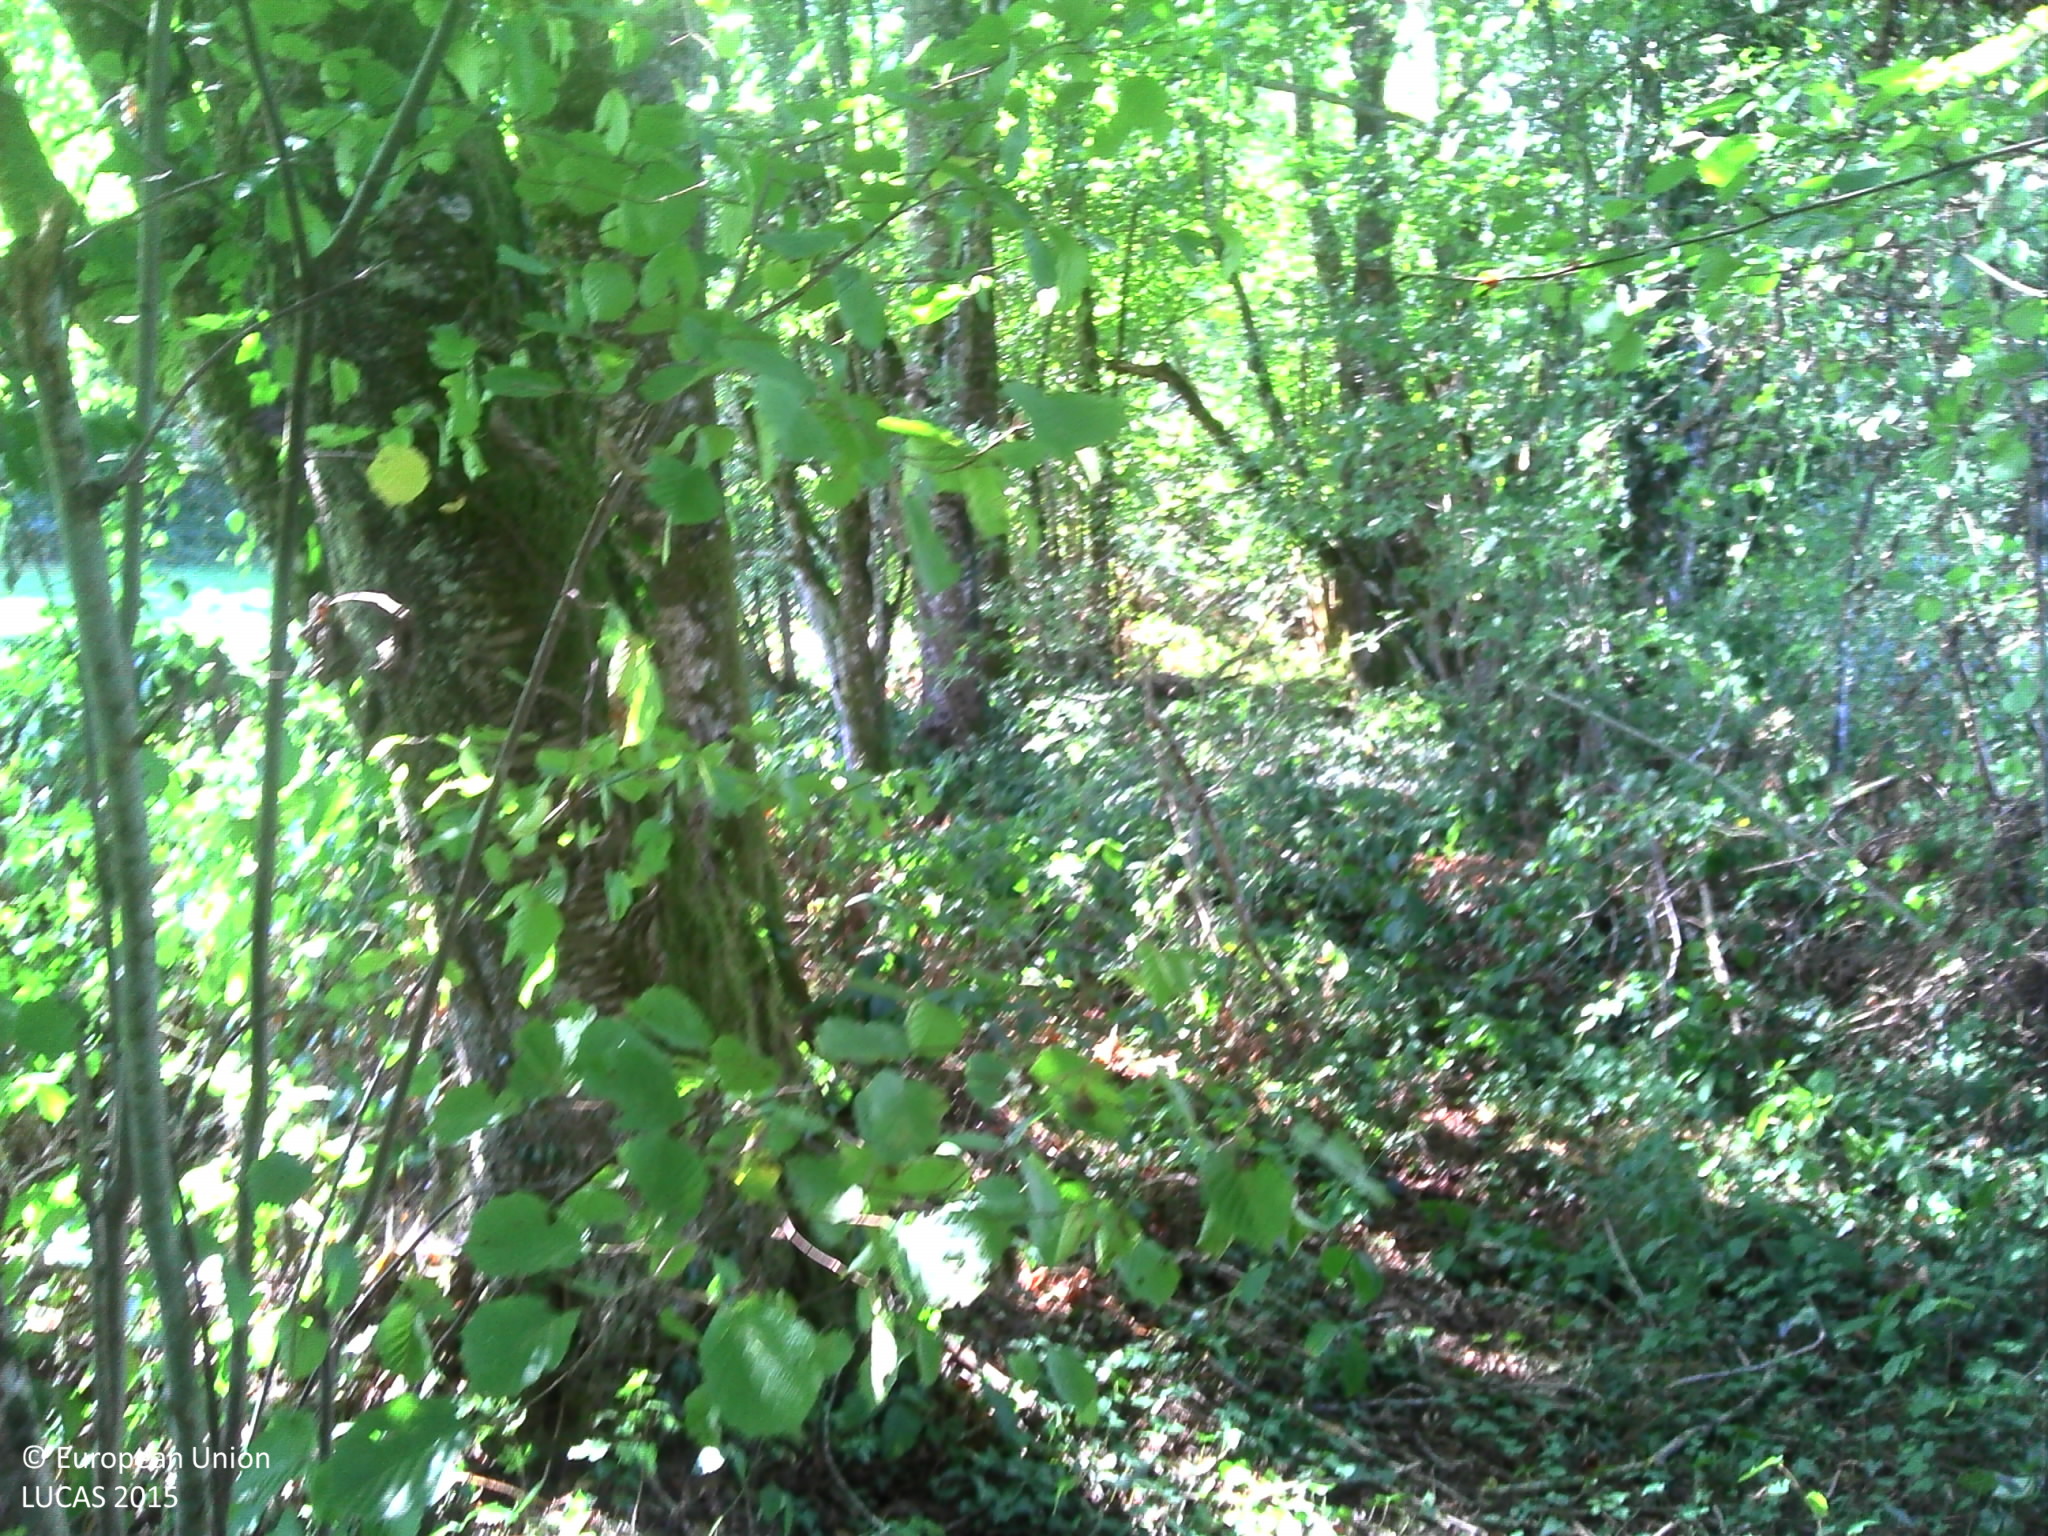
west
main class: Woodland
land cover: Broadleaved woodland
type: mesophytic deciduous forest
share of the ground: > 75 %
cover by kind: broadleaved forest trees 85 %, herbaceous plants 10 %
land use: Forestry
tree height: > 5 m
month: September
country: FR
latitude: 47.5231
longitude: 6.6150
